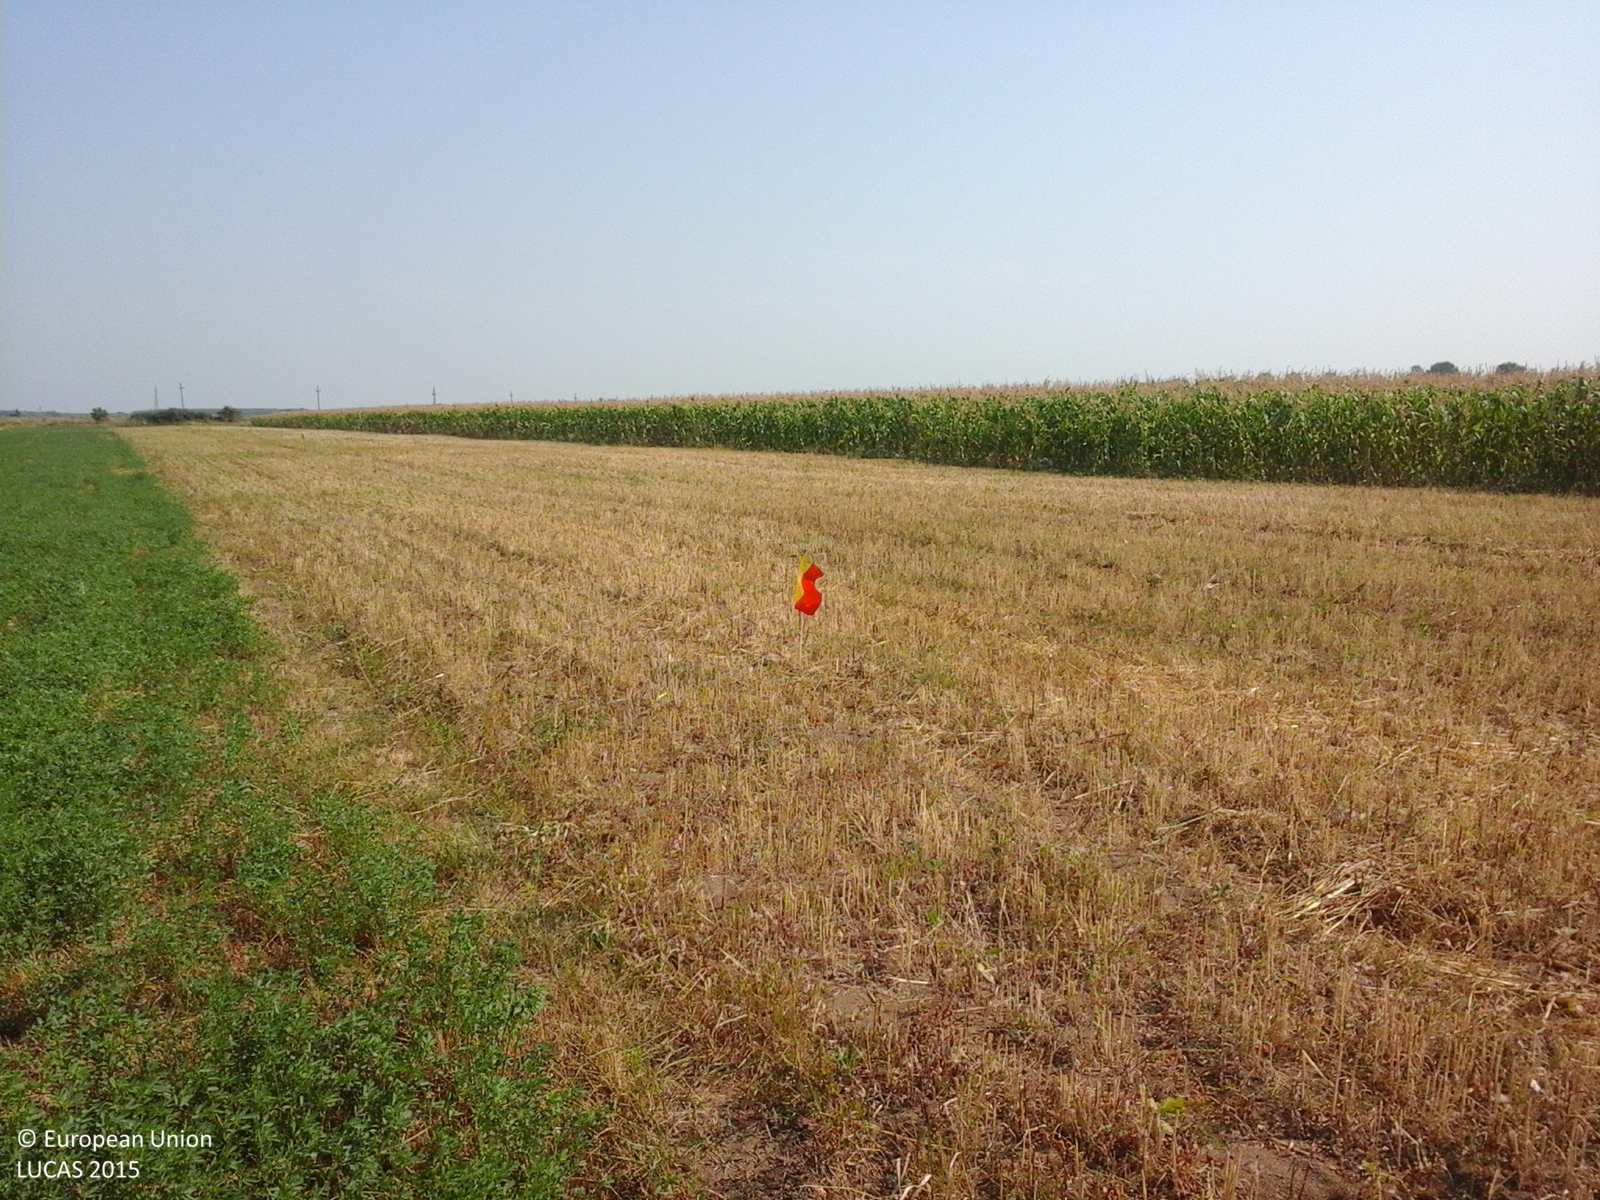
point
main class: Cropland
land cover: Common wheat
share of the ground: > 75 %
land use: Agriculture (excluding fallow land and kitchen gardens)
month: August
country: RO
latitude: 45.1532
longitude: 27.3819
